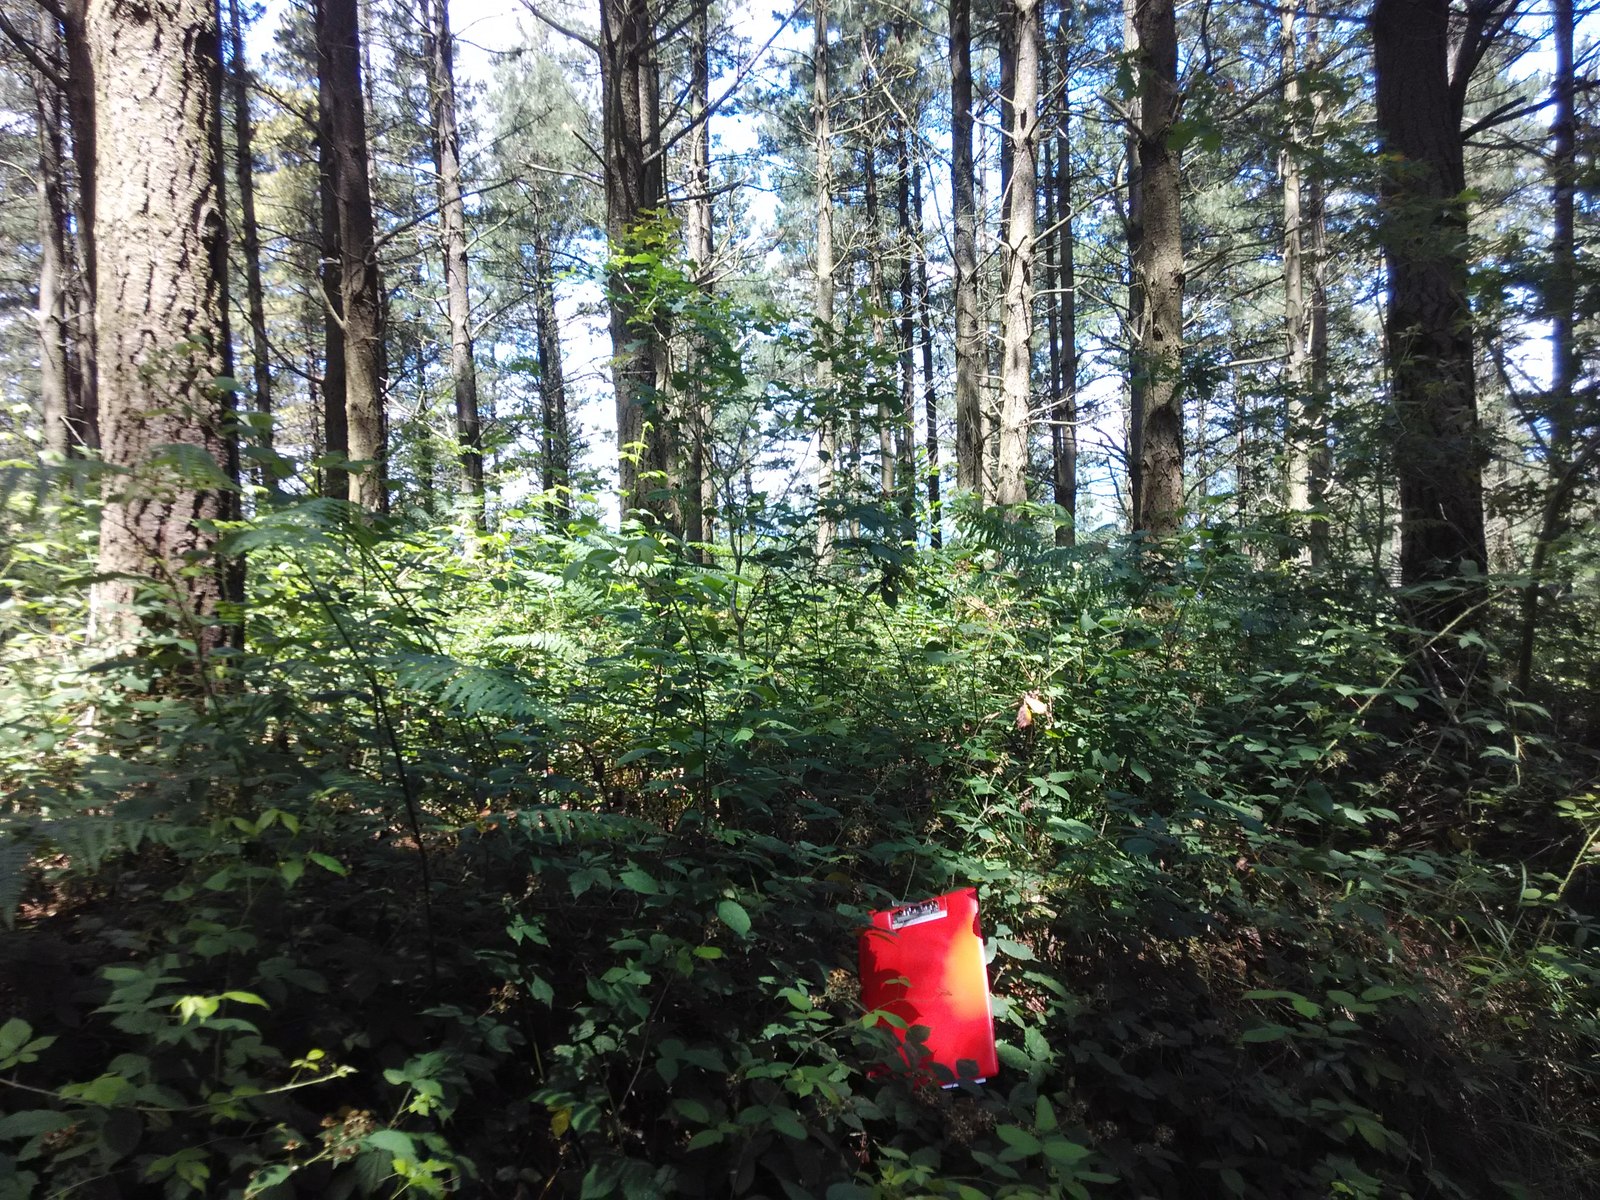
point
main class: Woodland
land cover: Pine dominated coniferous woodland
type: exotic forest
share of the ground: > 75 %
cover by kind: coniferous forest trees 100 %
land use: Forestry
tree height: > 5 m
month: July
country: ES
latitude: 43.1110
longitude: -2.5500
